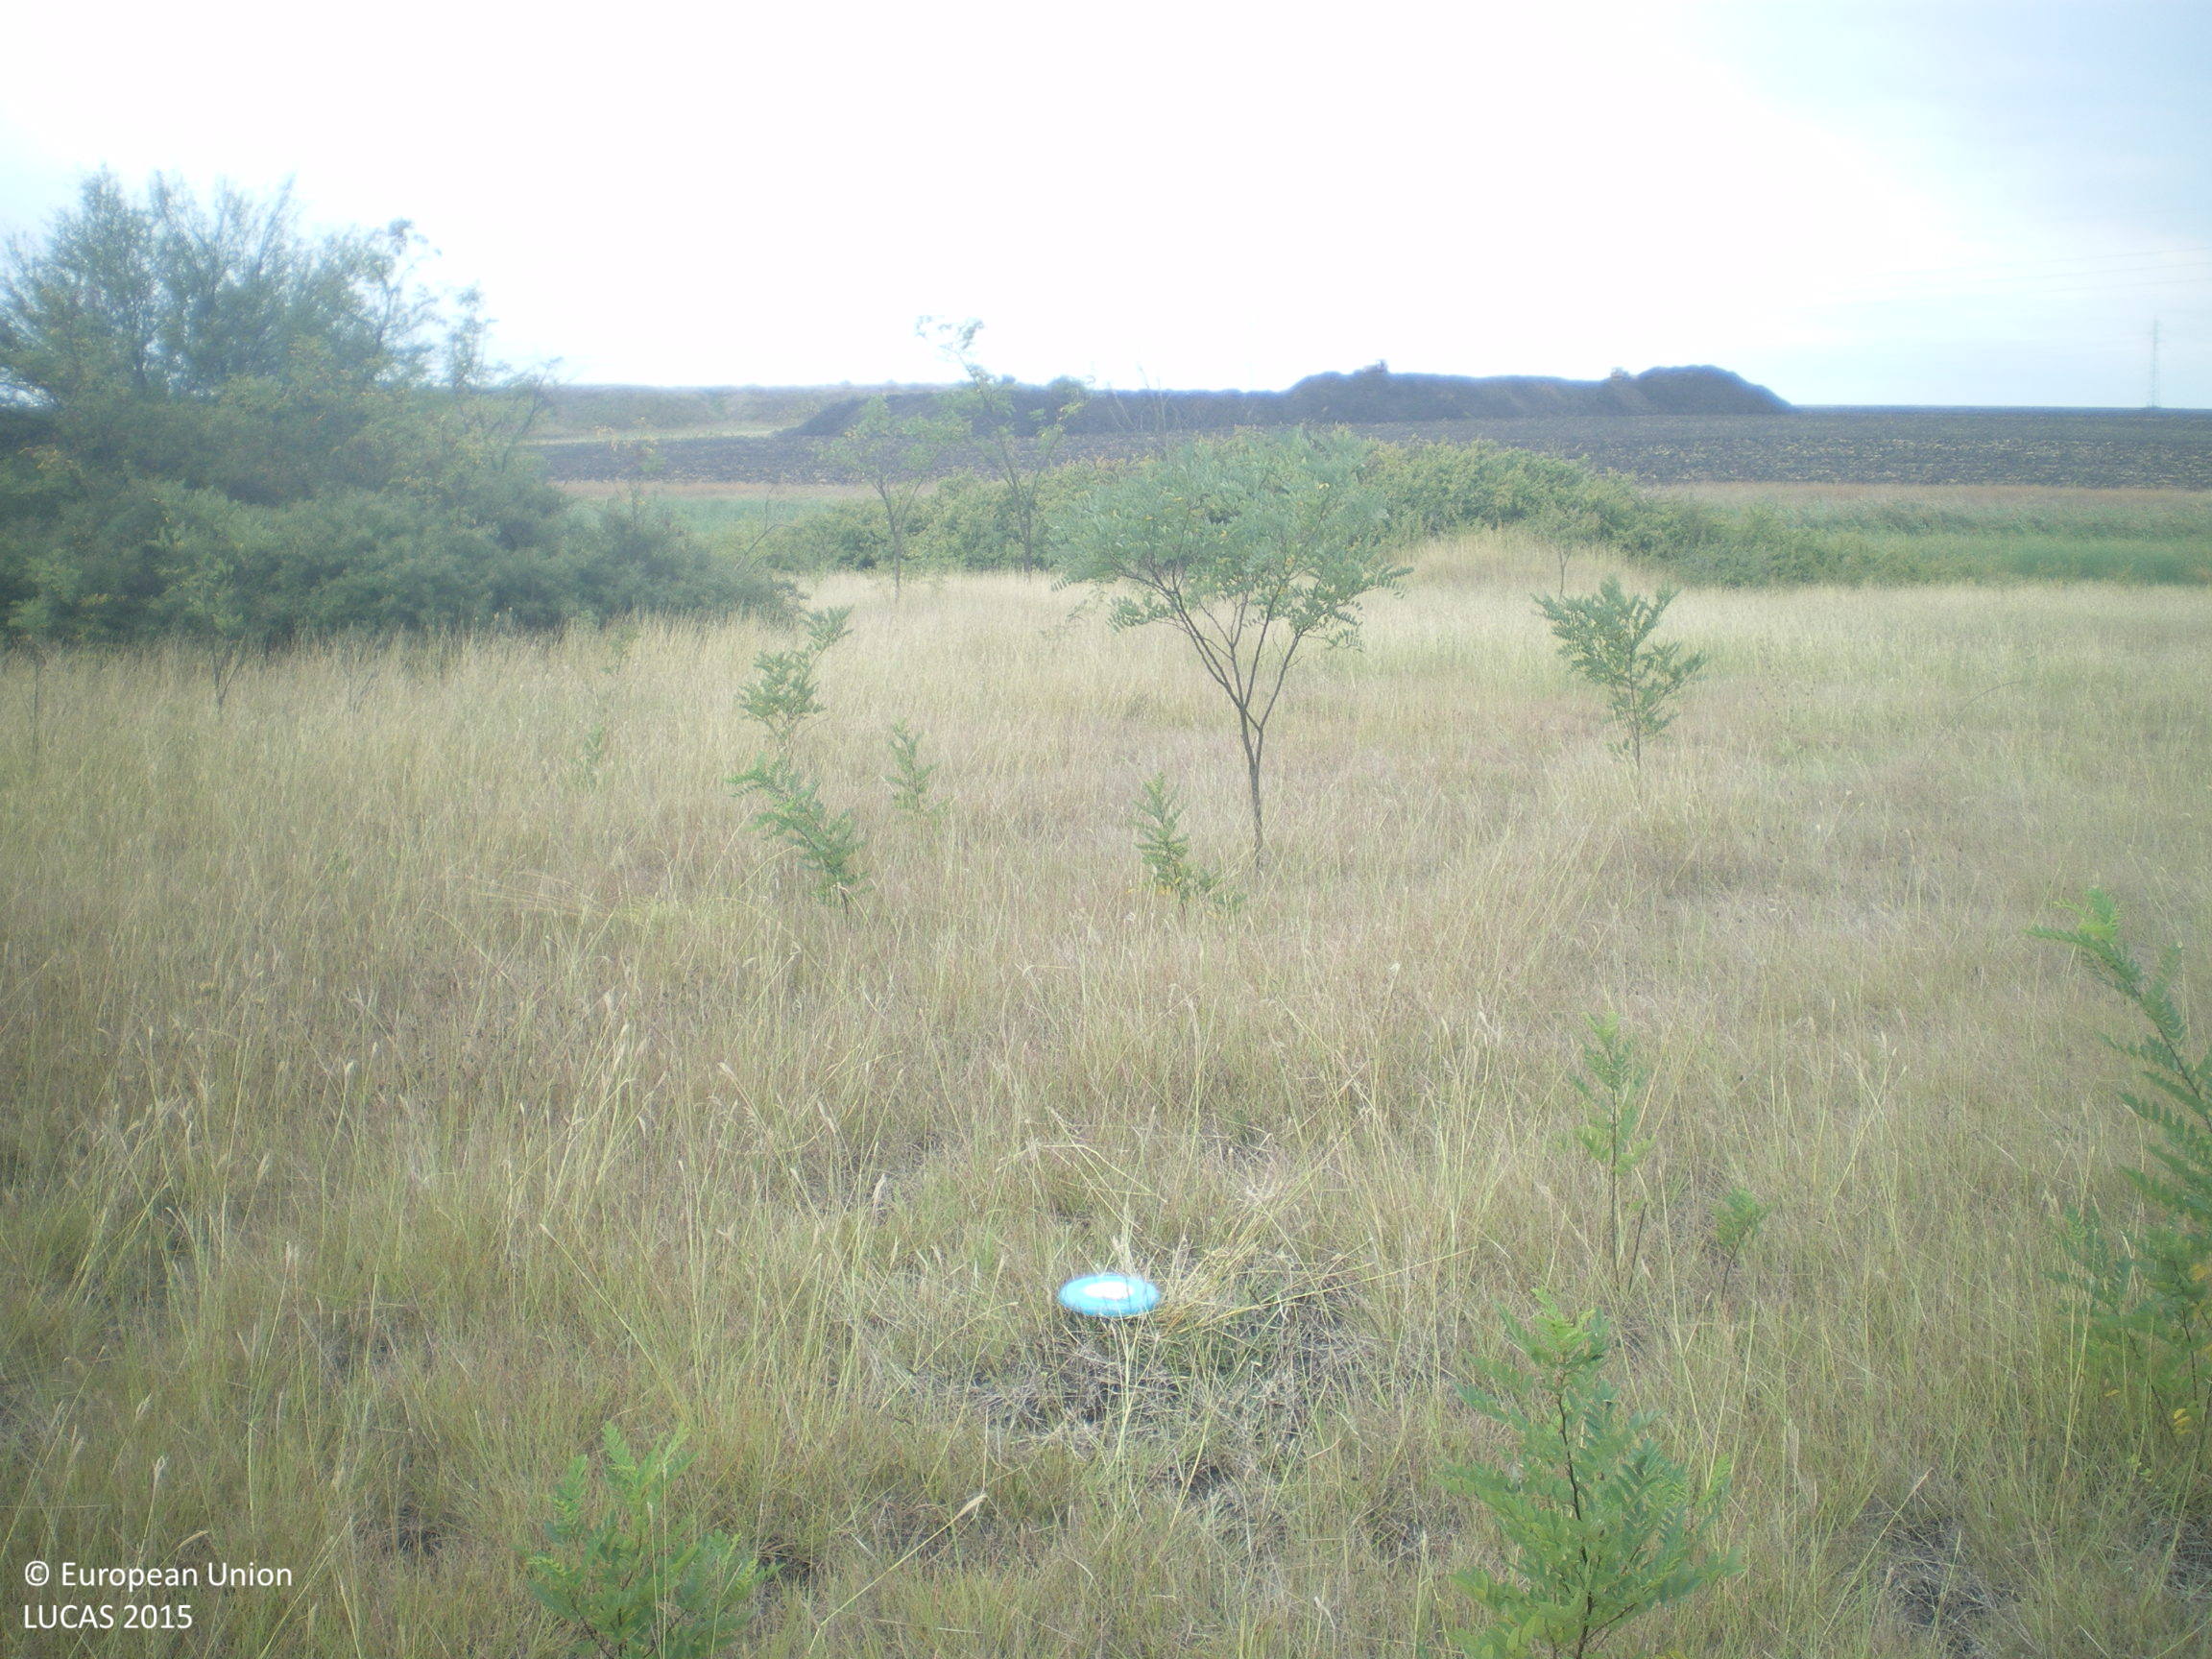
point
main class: Grassland
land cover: Grassland with sparse tree/shrub cover
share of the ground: > 75 %
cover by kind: herbaceous plants 90 %, broadleaved forest trees 5 %, shrubs 5 %
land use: Semi-natural and natural areas not in use
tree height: > 5 m
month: September
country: BG
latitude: 42.2594
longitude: 25.9692
